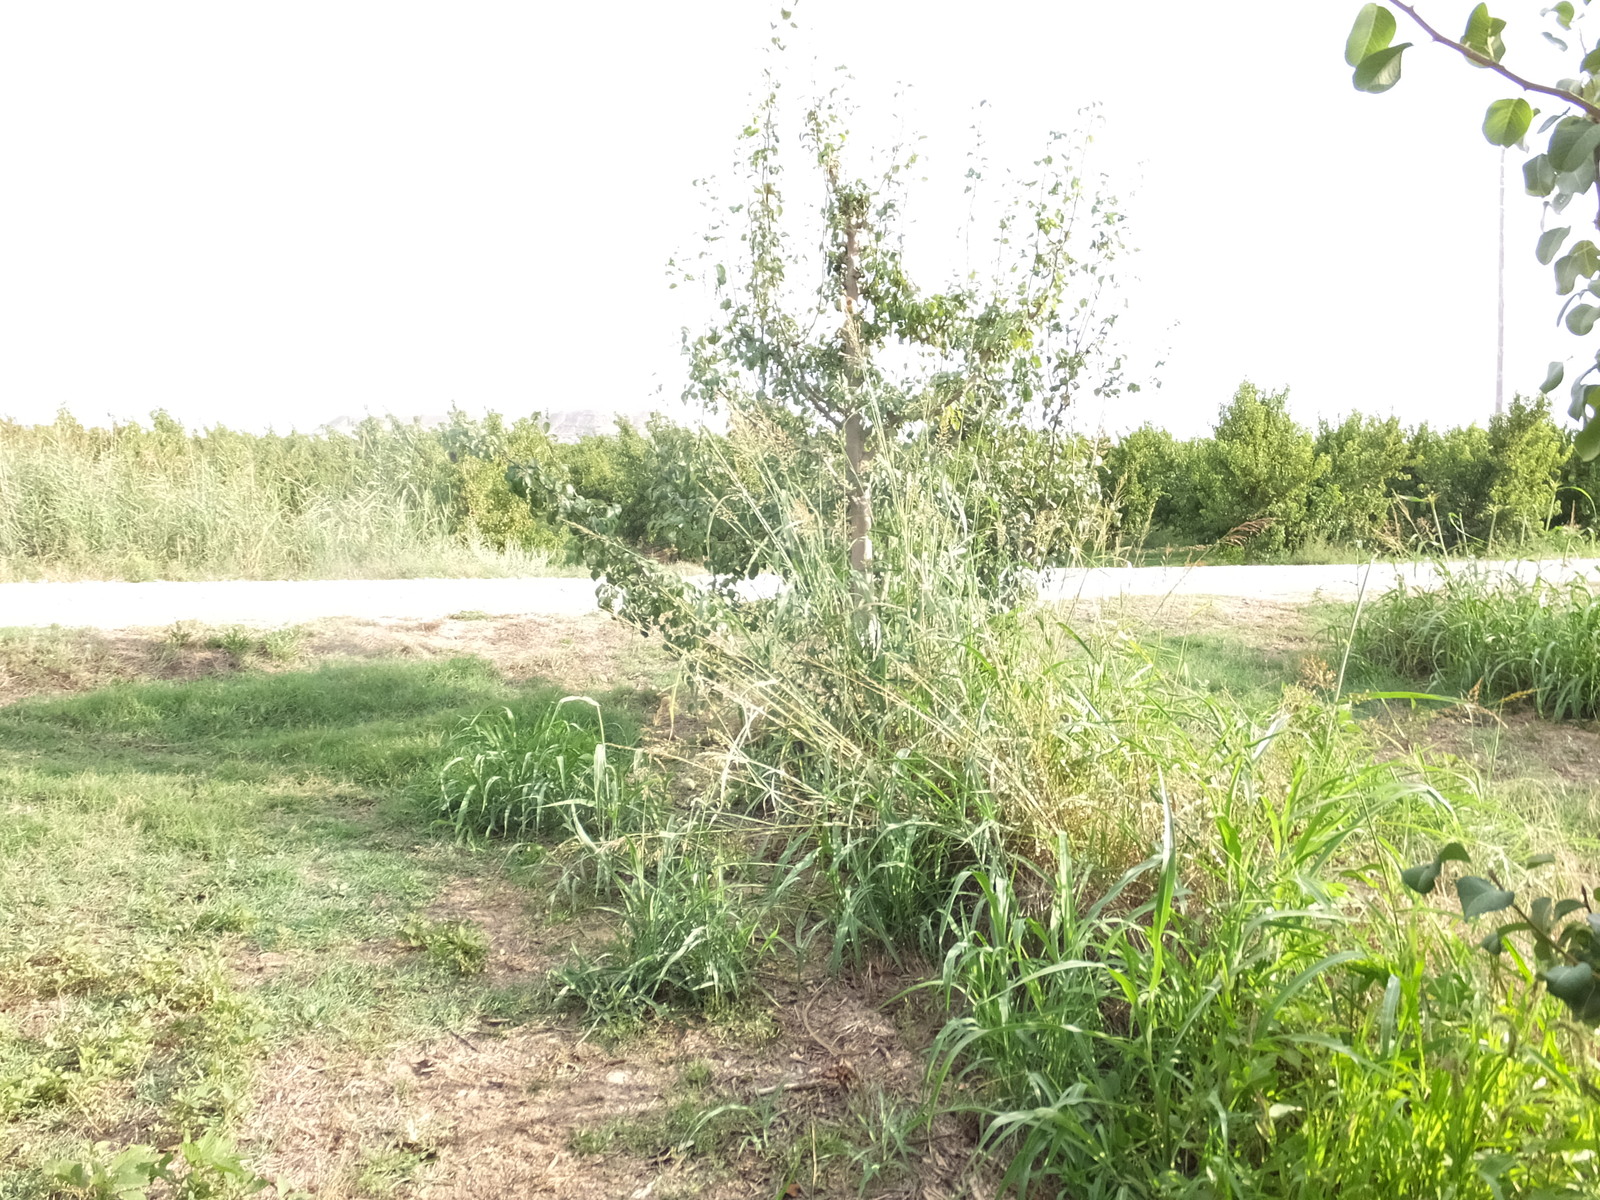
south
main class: Cropland
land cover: Pear fruit
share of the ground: > 75 %
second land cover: Spontaneously vegetated surfaces
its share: 10 - 25 %
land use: Agriculture (excluding fallow land and kitchen gardens)
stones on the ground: < 10 %
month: August
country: ES
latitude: 41.5278
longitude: 0.4358
